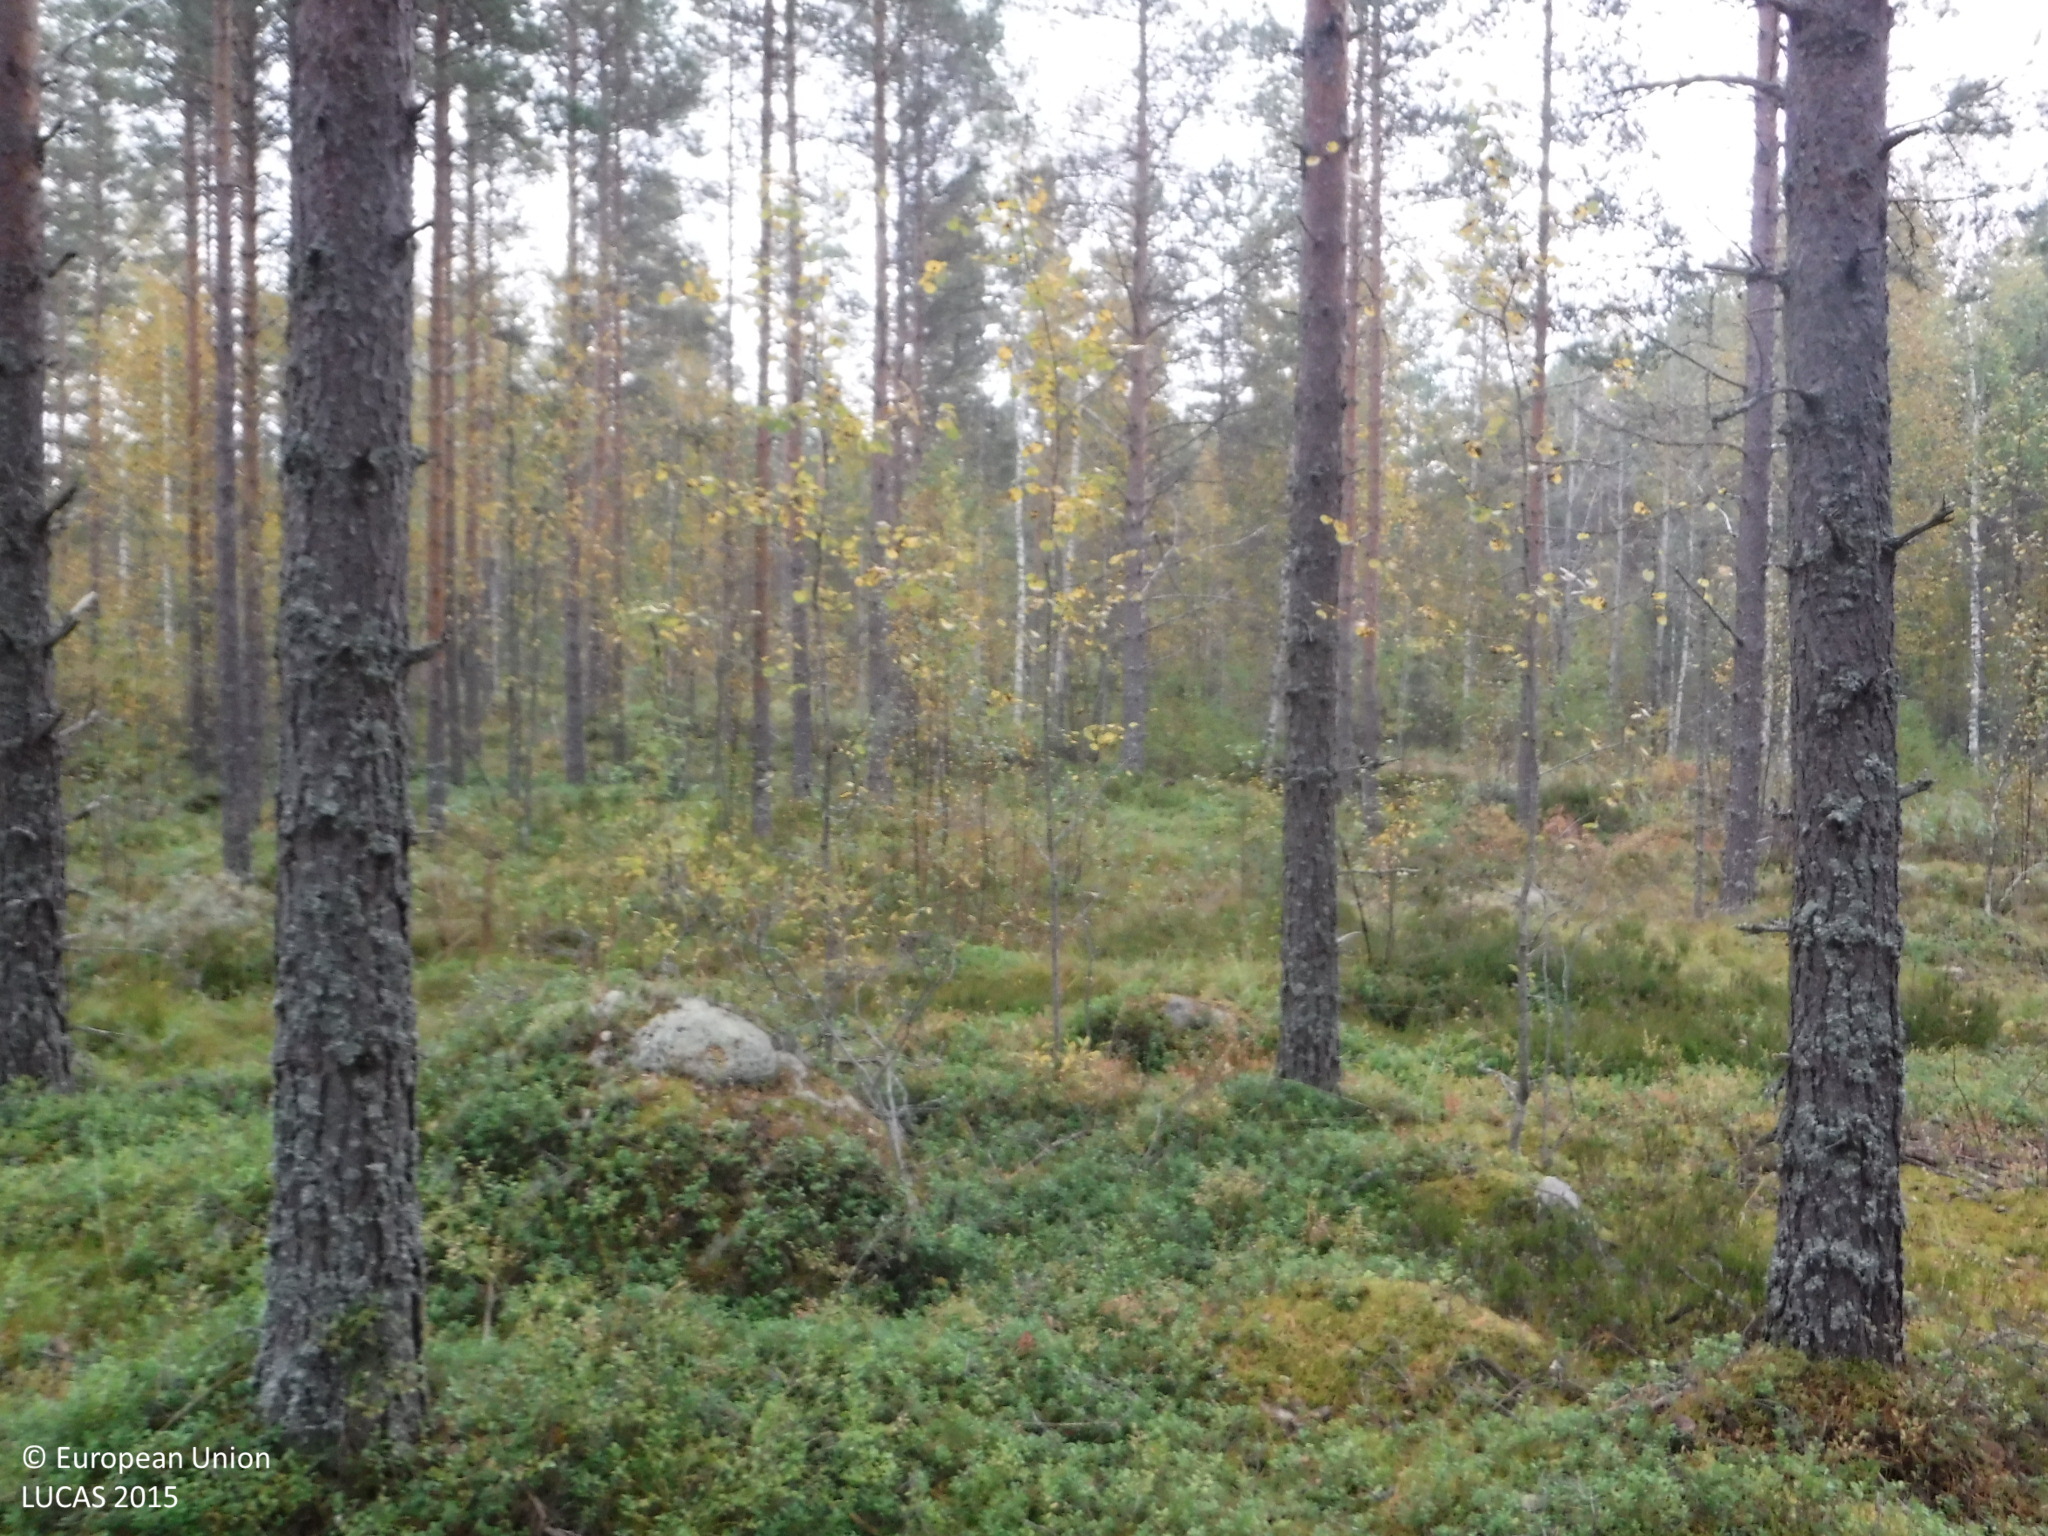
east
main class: Woodland
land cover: Pine dominated coniferous woodland
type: boreal forest
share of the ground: 25 - 50 %
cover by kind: coniferous forest trees 45 %, shrubs 30 %, lichens and mosses 25 %
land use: Forestry
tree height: > 5 m
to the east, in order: Pine dominated coniferous woodland; Ditches and canals; Grass margins; Paved roads, cycling and walking lanes; Groves; Ditches and canals; Pine dominated coniferous woodland; Pine dominated mixed woodland
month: September
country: FI
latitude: 61.9435
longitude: 22.2735
